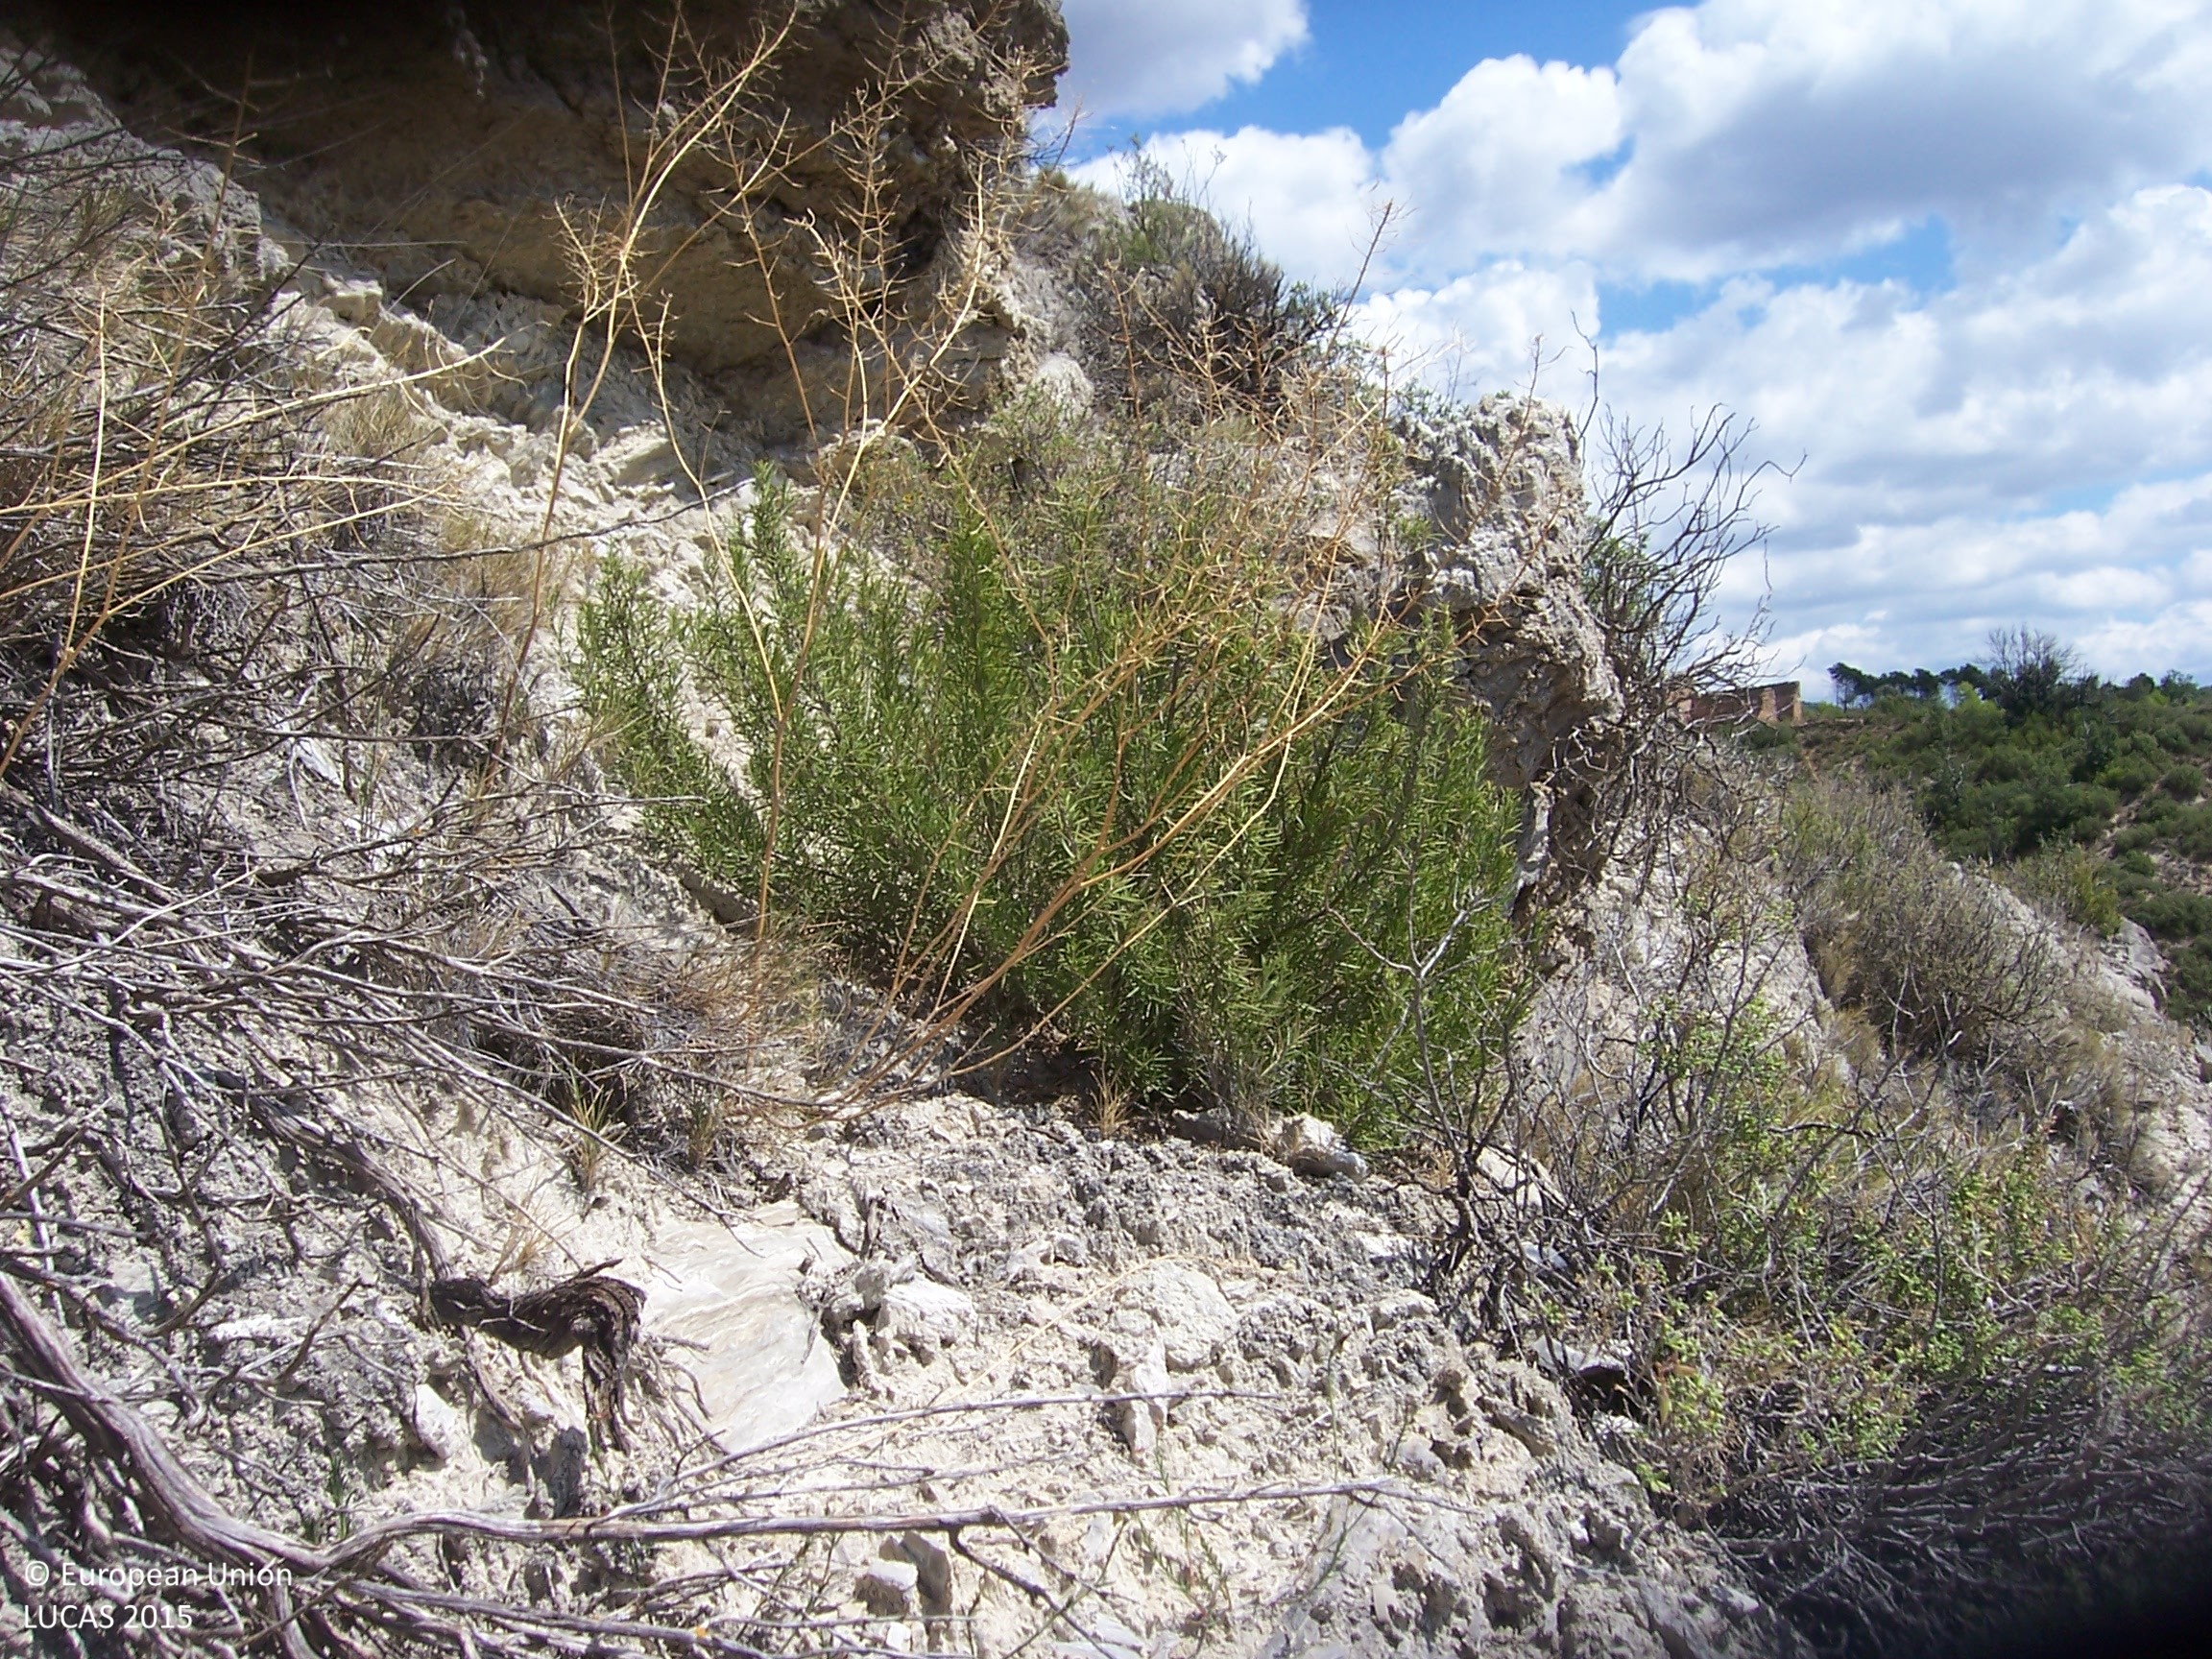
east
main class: Shrubland
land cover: Shrubland without tree cover
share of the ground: > 75 %
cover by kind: consolidated bare surface 50 %, unconsolidated bare surface 35 %, shrubs 15 %
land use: Semi-natural and natural areas not in use
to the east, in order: Shrubland without tree cover; Broadleaved woodland; Shrubland without tree cover; Tracks; Shrubland without tree cover
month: August
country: ES
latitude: 42.0137
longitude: 0.3834
